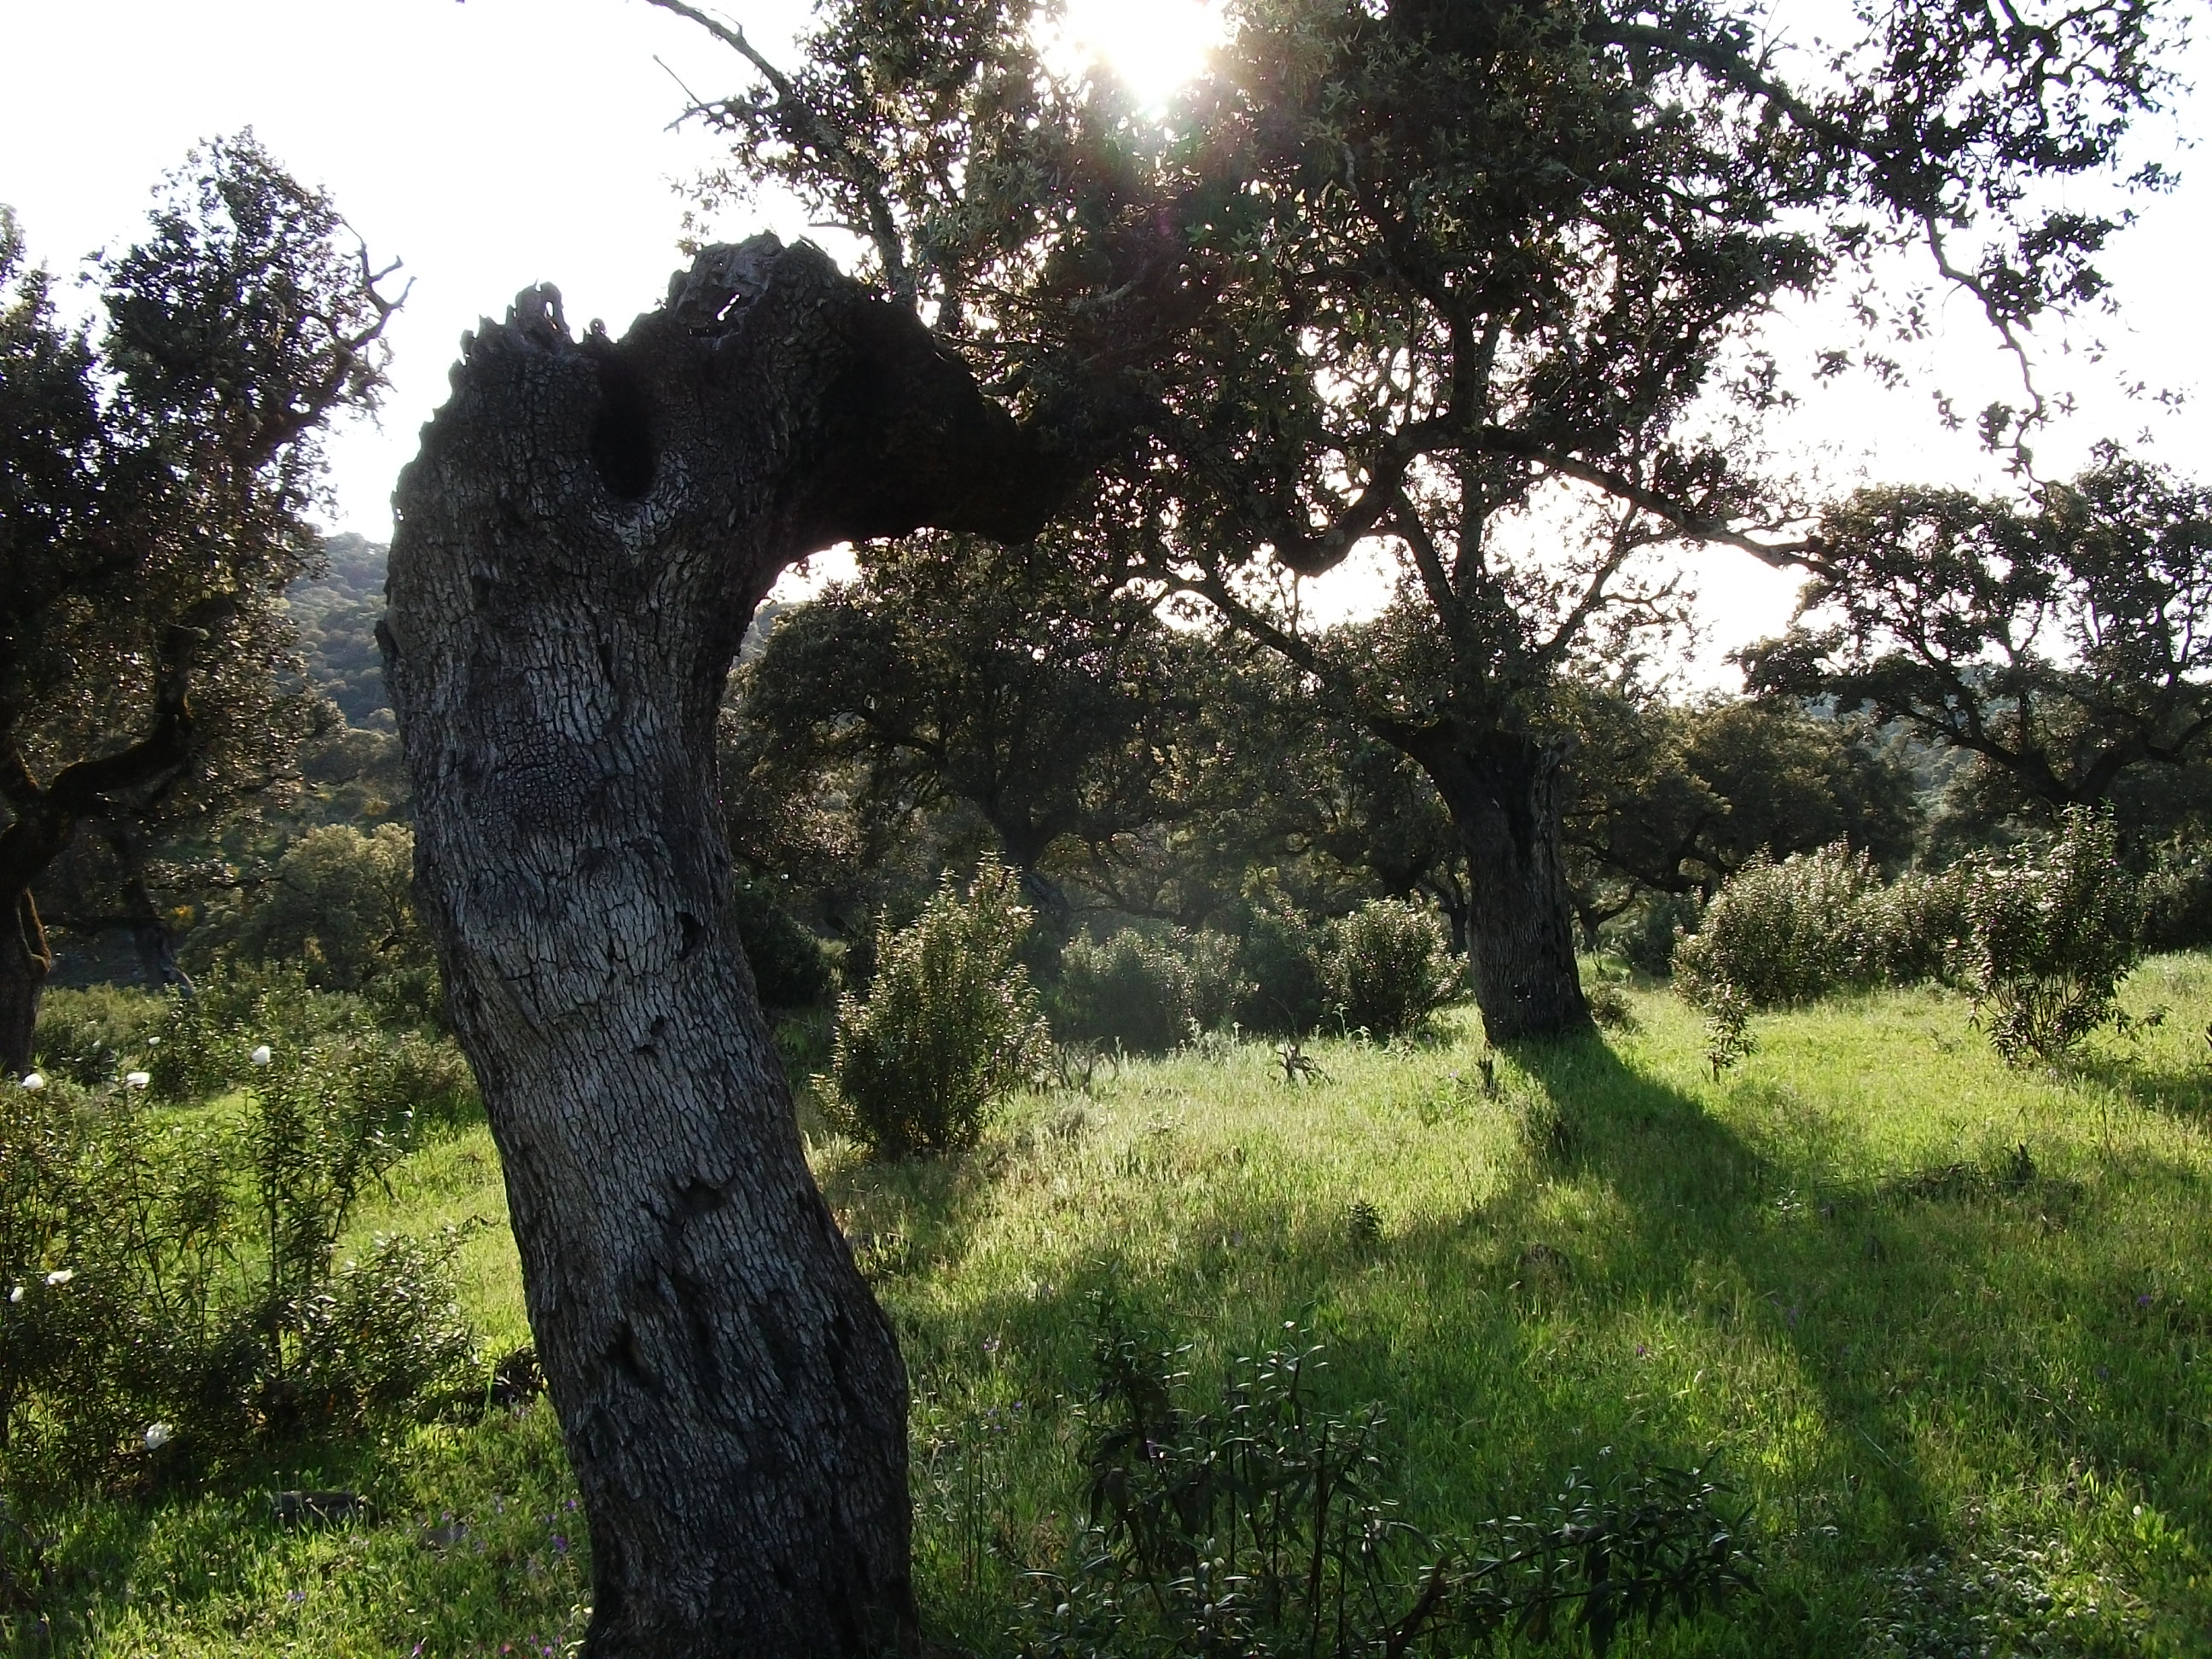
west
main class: Woodland
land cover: Broadleaved woodland
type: broadleaved evergreen forest
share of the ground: 25 - 50 %
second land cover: Spontaneously vegetated surfaces
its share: 50 - 75 %
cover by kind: herbaceous plants 50 %, broadleaved forest trees 40 %, shrubs 10 %
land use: Forestry
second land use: Agriculture (excluding fallow land and kitchen gardens)
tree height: > 5 m
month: April
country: ES
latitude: 38.0936
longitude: -6.6625
